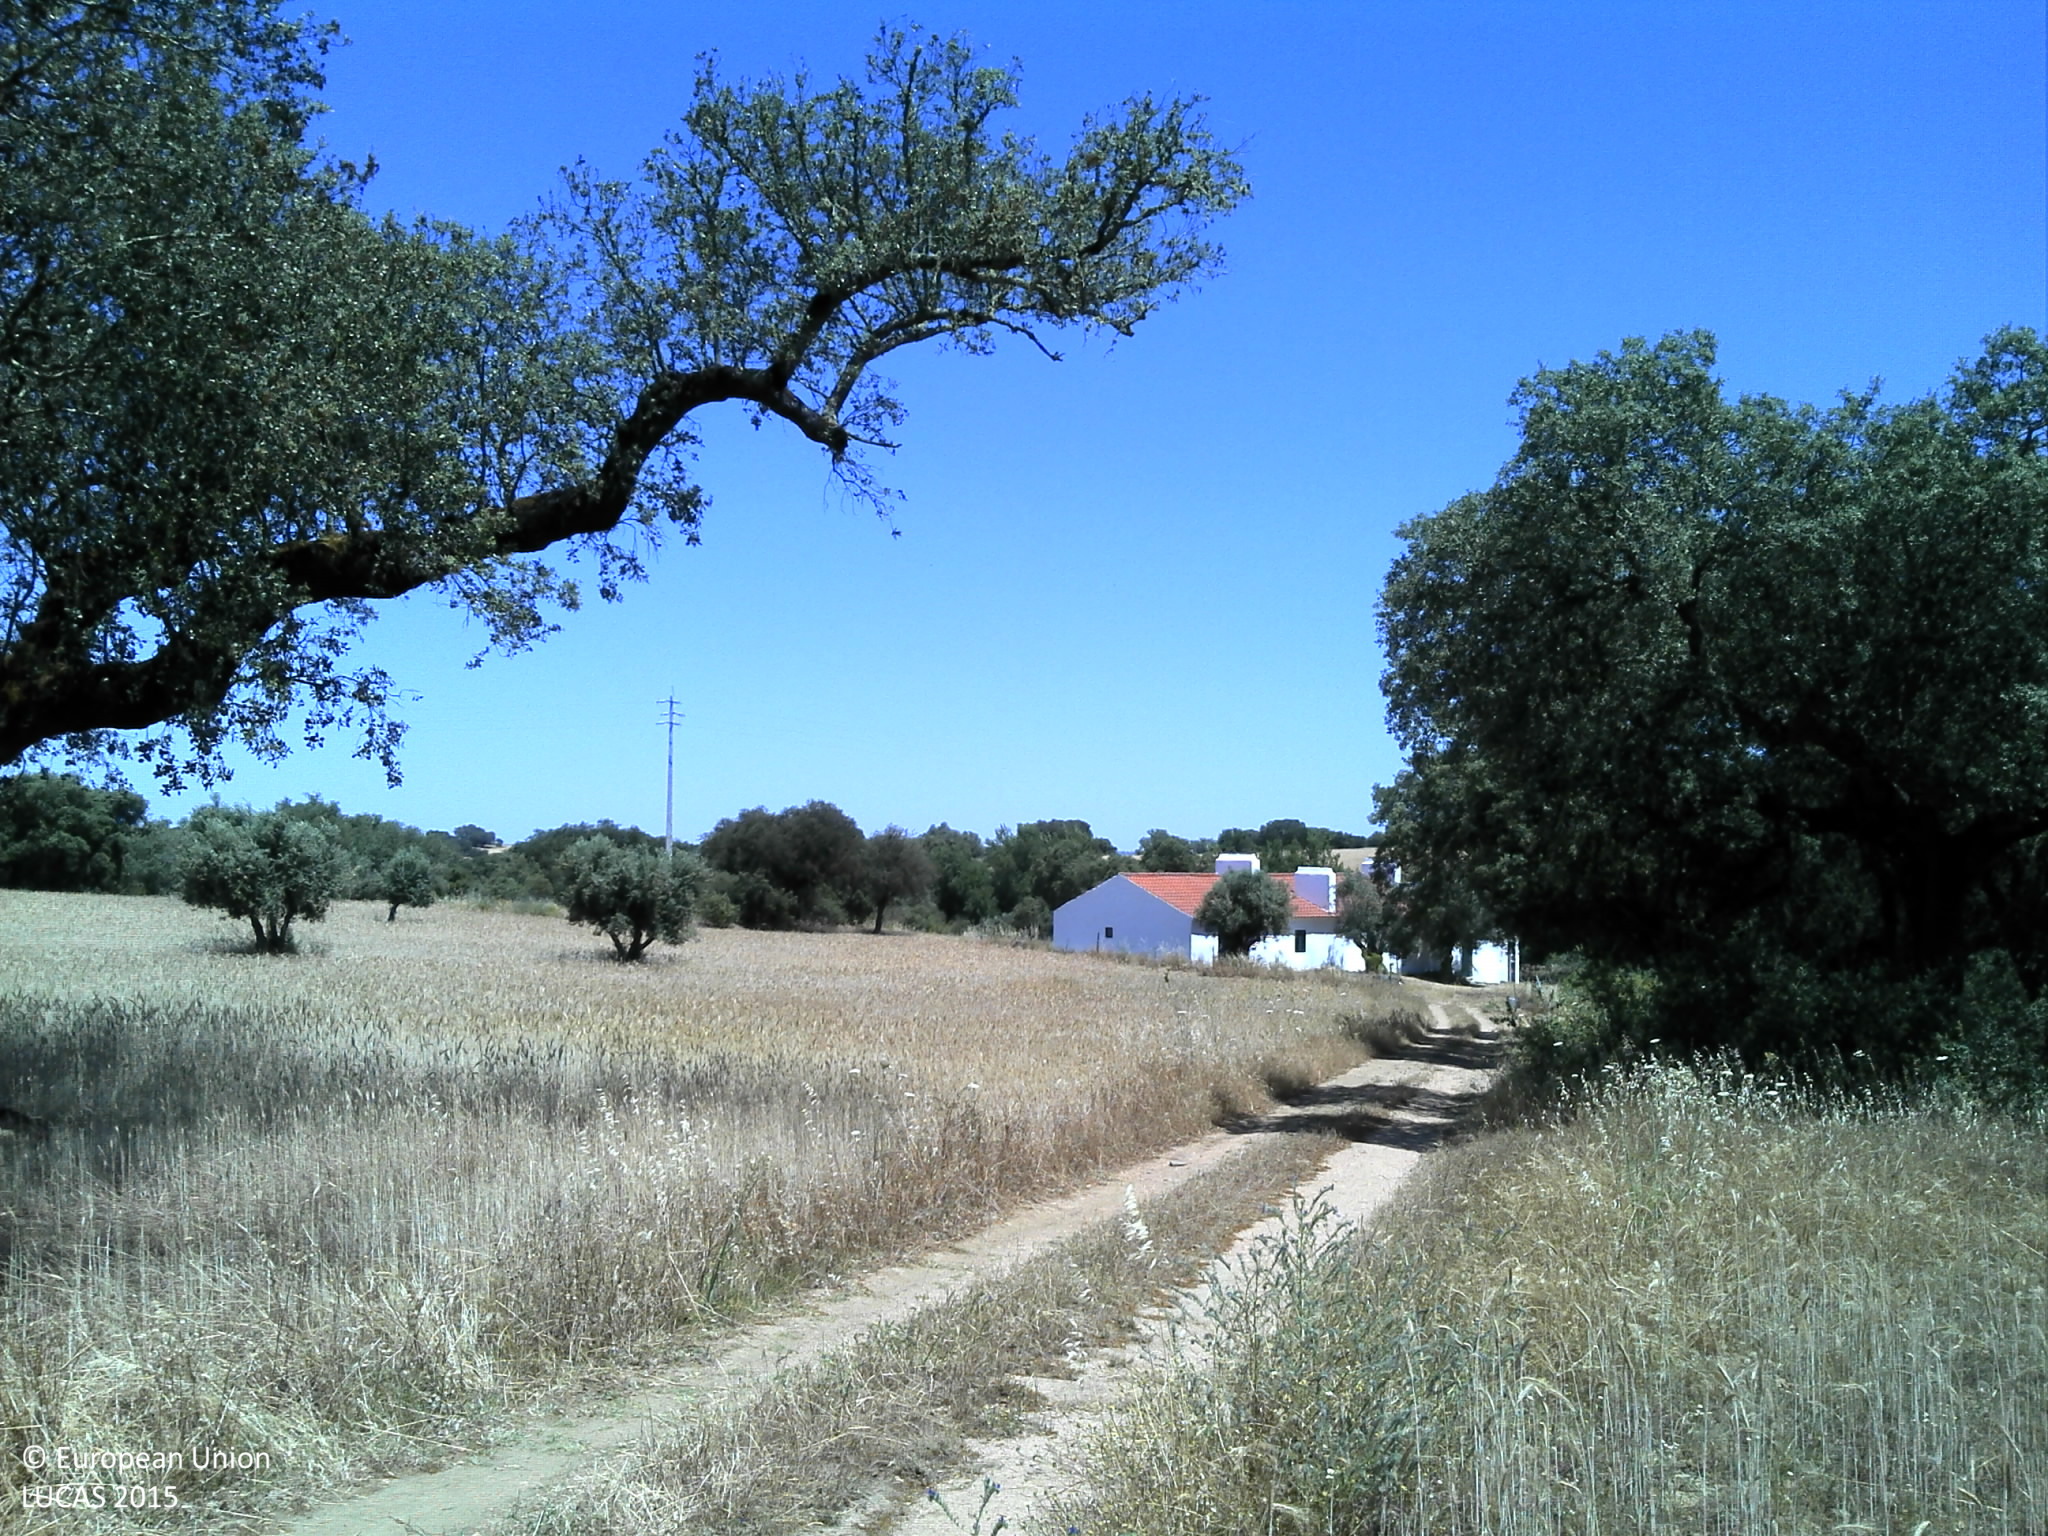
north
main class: Woodland
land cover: Broadleaved woodland
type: broadleaved evergreen forest
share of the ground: 25 - 50 %
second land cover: Triticale
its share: 50 - 75 %
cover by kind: herbaceous plants 60 %, broadleaved forest trees 30 %, unconsolidated bare surface 10 %
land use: Forestry
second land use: Agriculture (excluding fallow land and kitchen gardens)
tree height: > 5 m
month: May
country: PT
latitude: 39.0160
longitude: -7.5834
